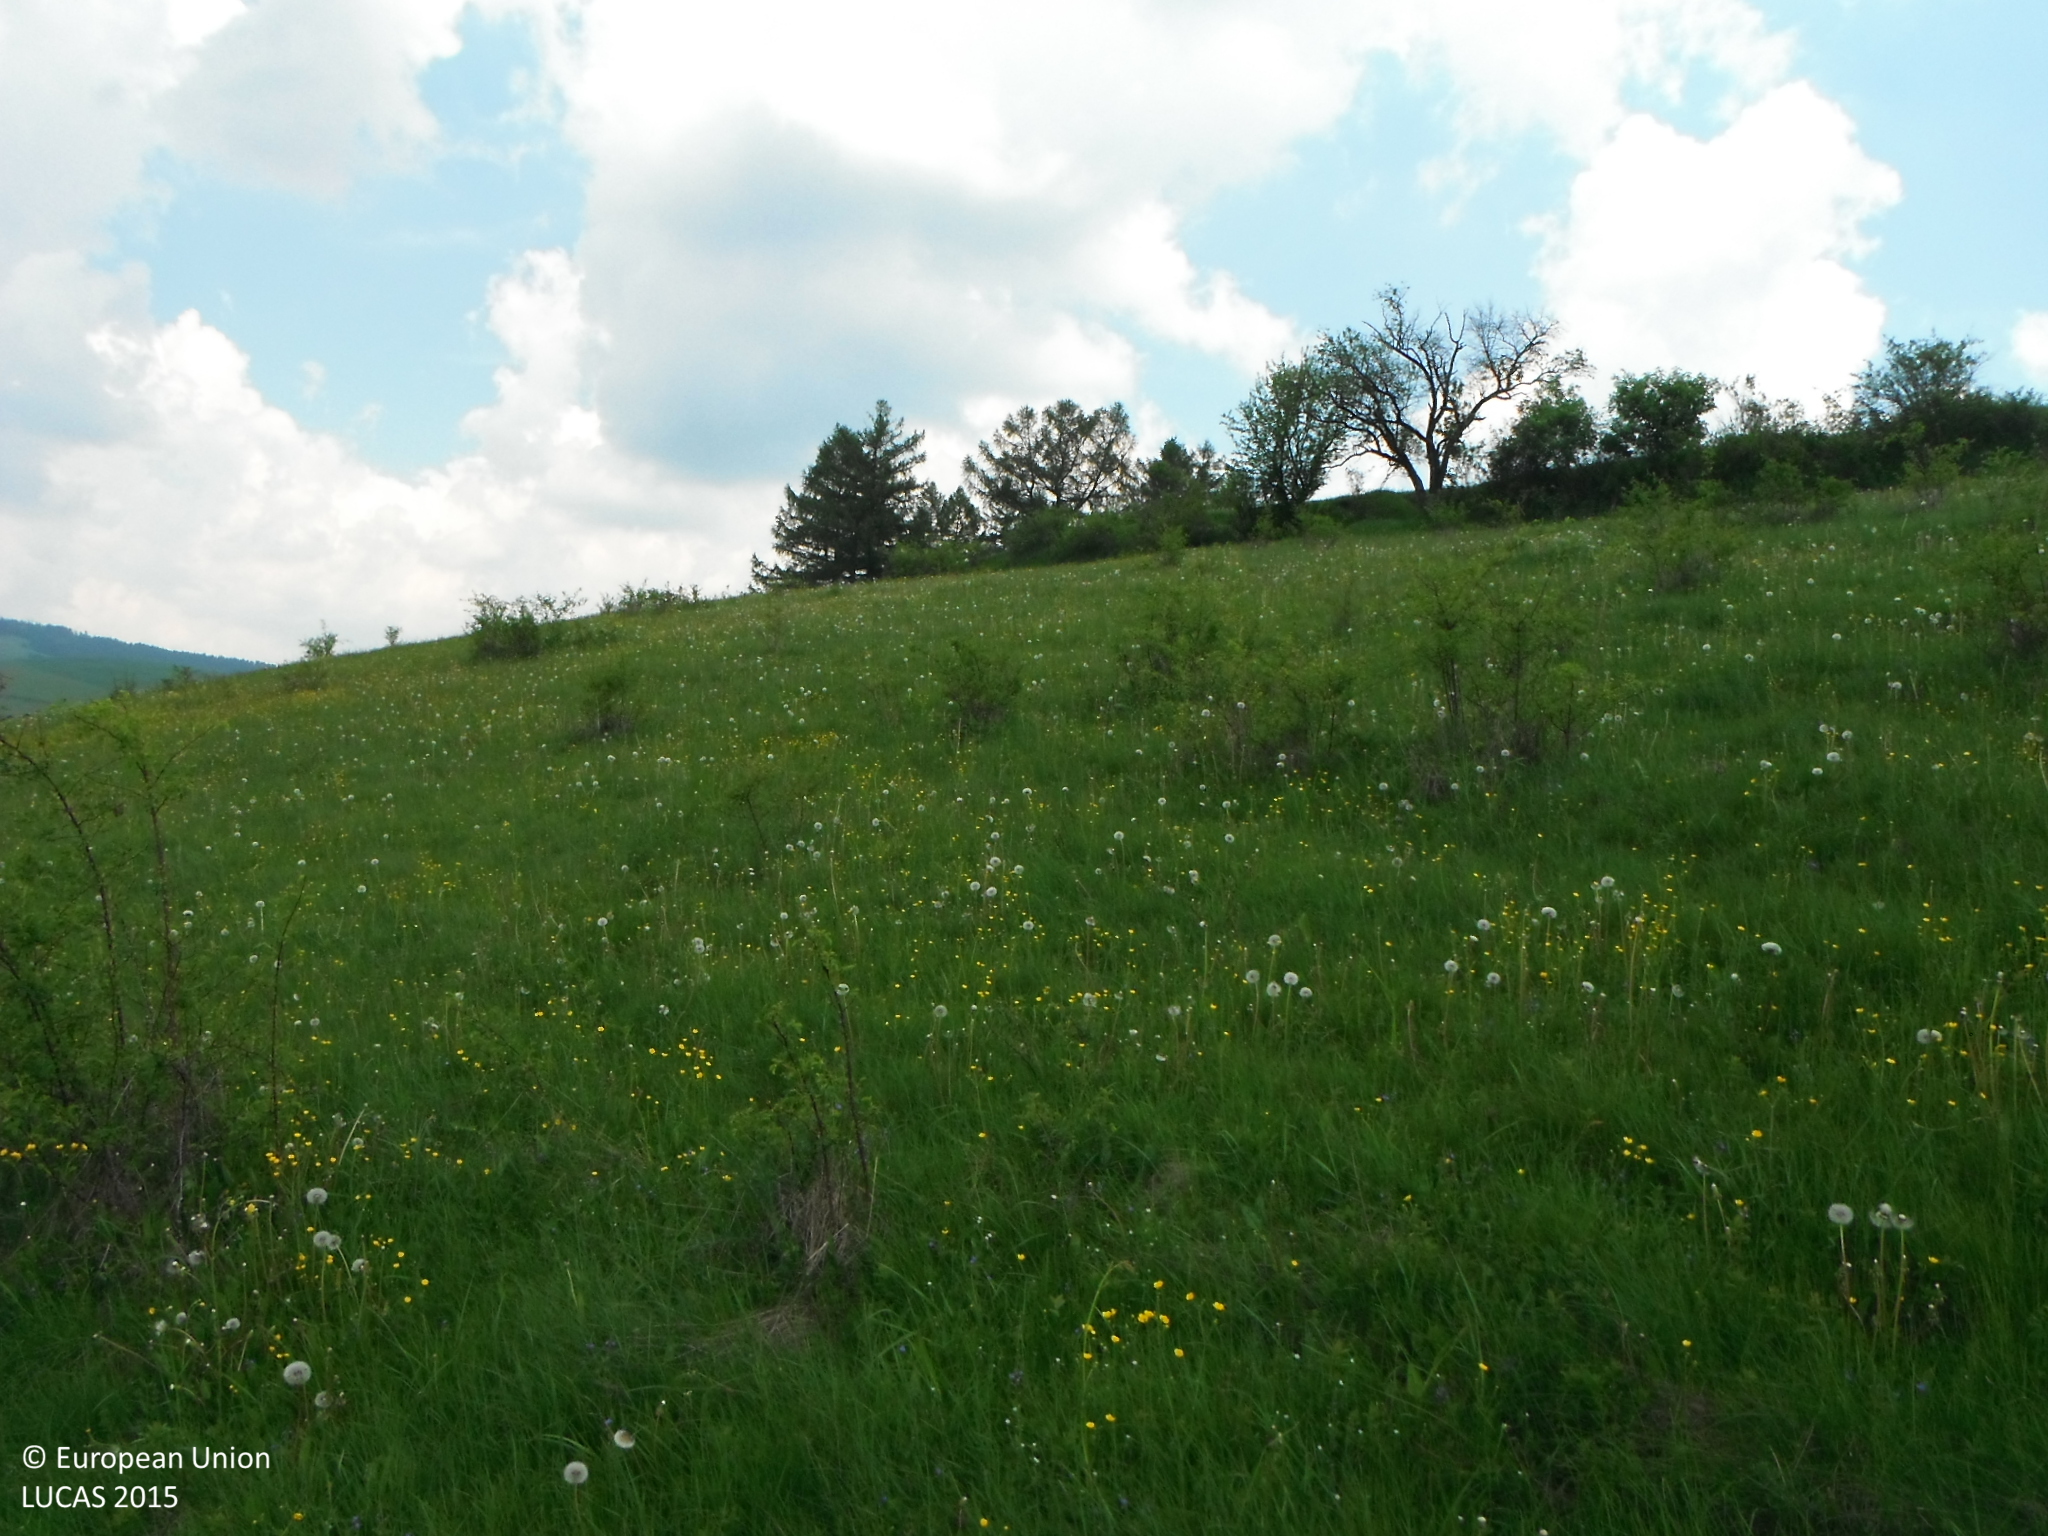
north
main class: Grassland
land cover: Grassland without tree/shrub cover
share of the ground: > 75 %
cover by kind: herbaceous plants 100 %
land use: Agriculture (excluding fallow land and kitchen gardens)
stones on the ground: < 10 %
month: June
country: SK
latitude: 49.0801
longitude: 20.7037
